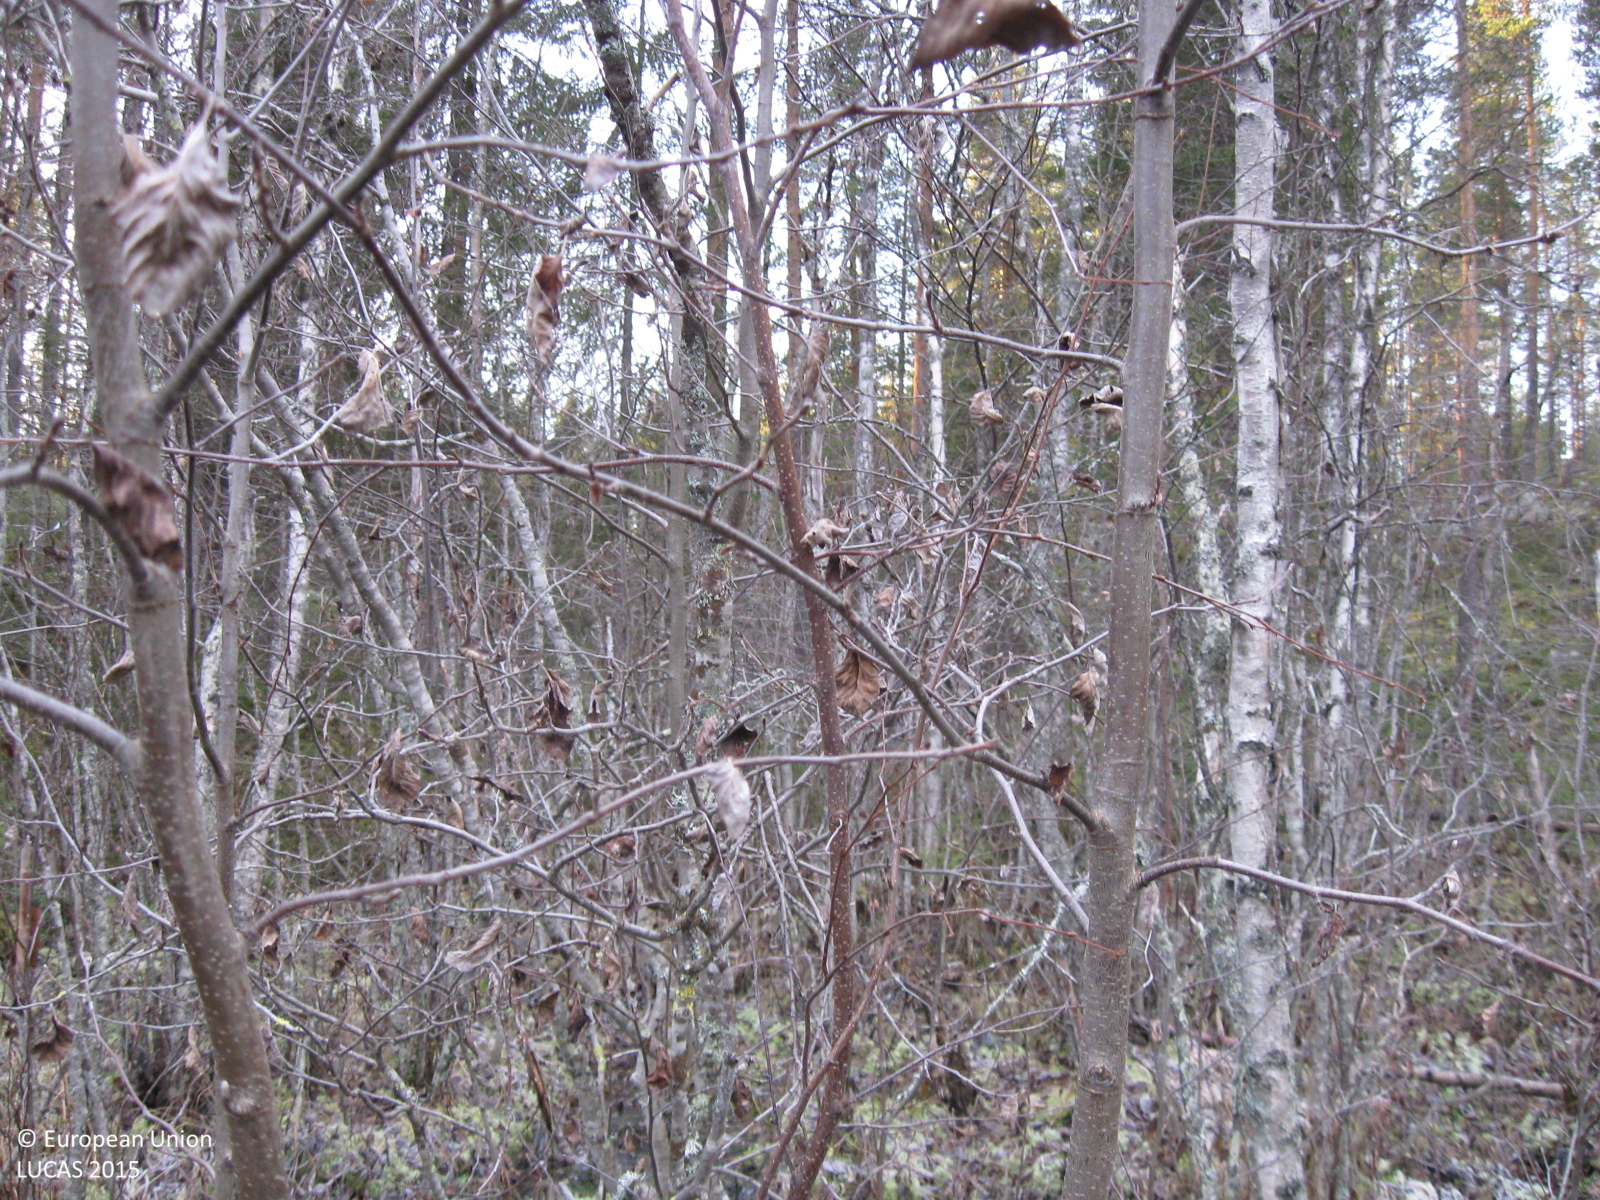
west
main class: Woodland
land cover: Broadleaved woodland
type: mire and swamp forests
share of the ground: > 75 %
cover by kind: broadleaved forest trees 75 %, herbaceous plants 10 %, lichens and mosses 10 %
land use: Semi-natural and natural areas not in use
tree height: < 5 m
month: October
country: SE
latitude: 66.1680
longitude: 21.6115
